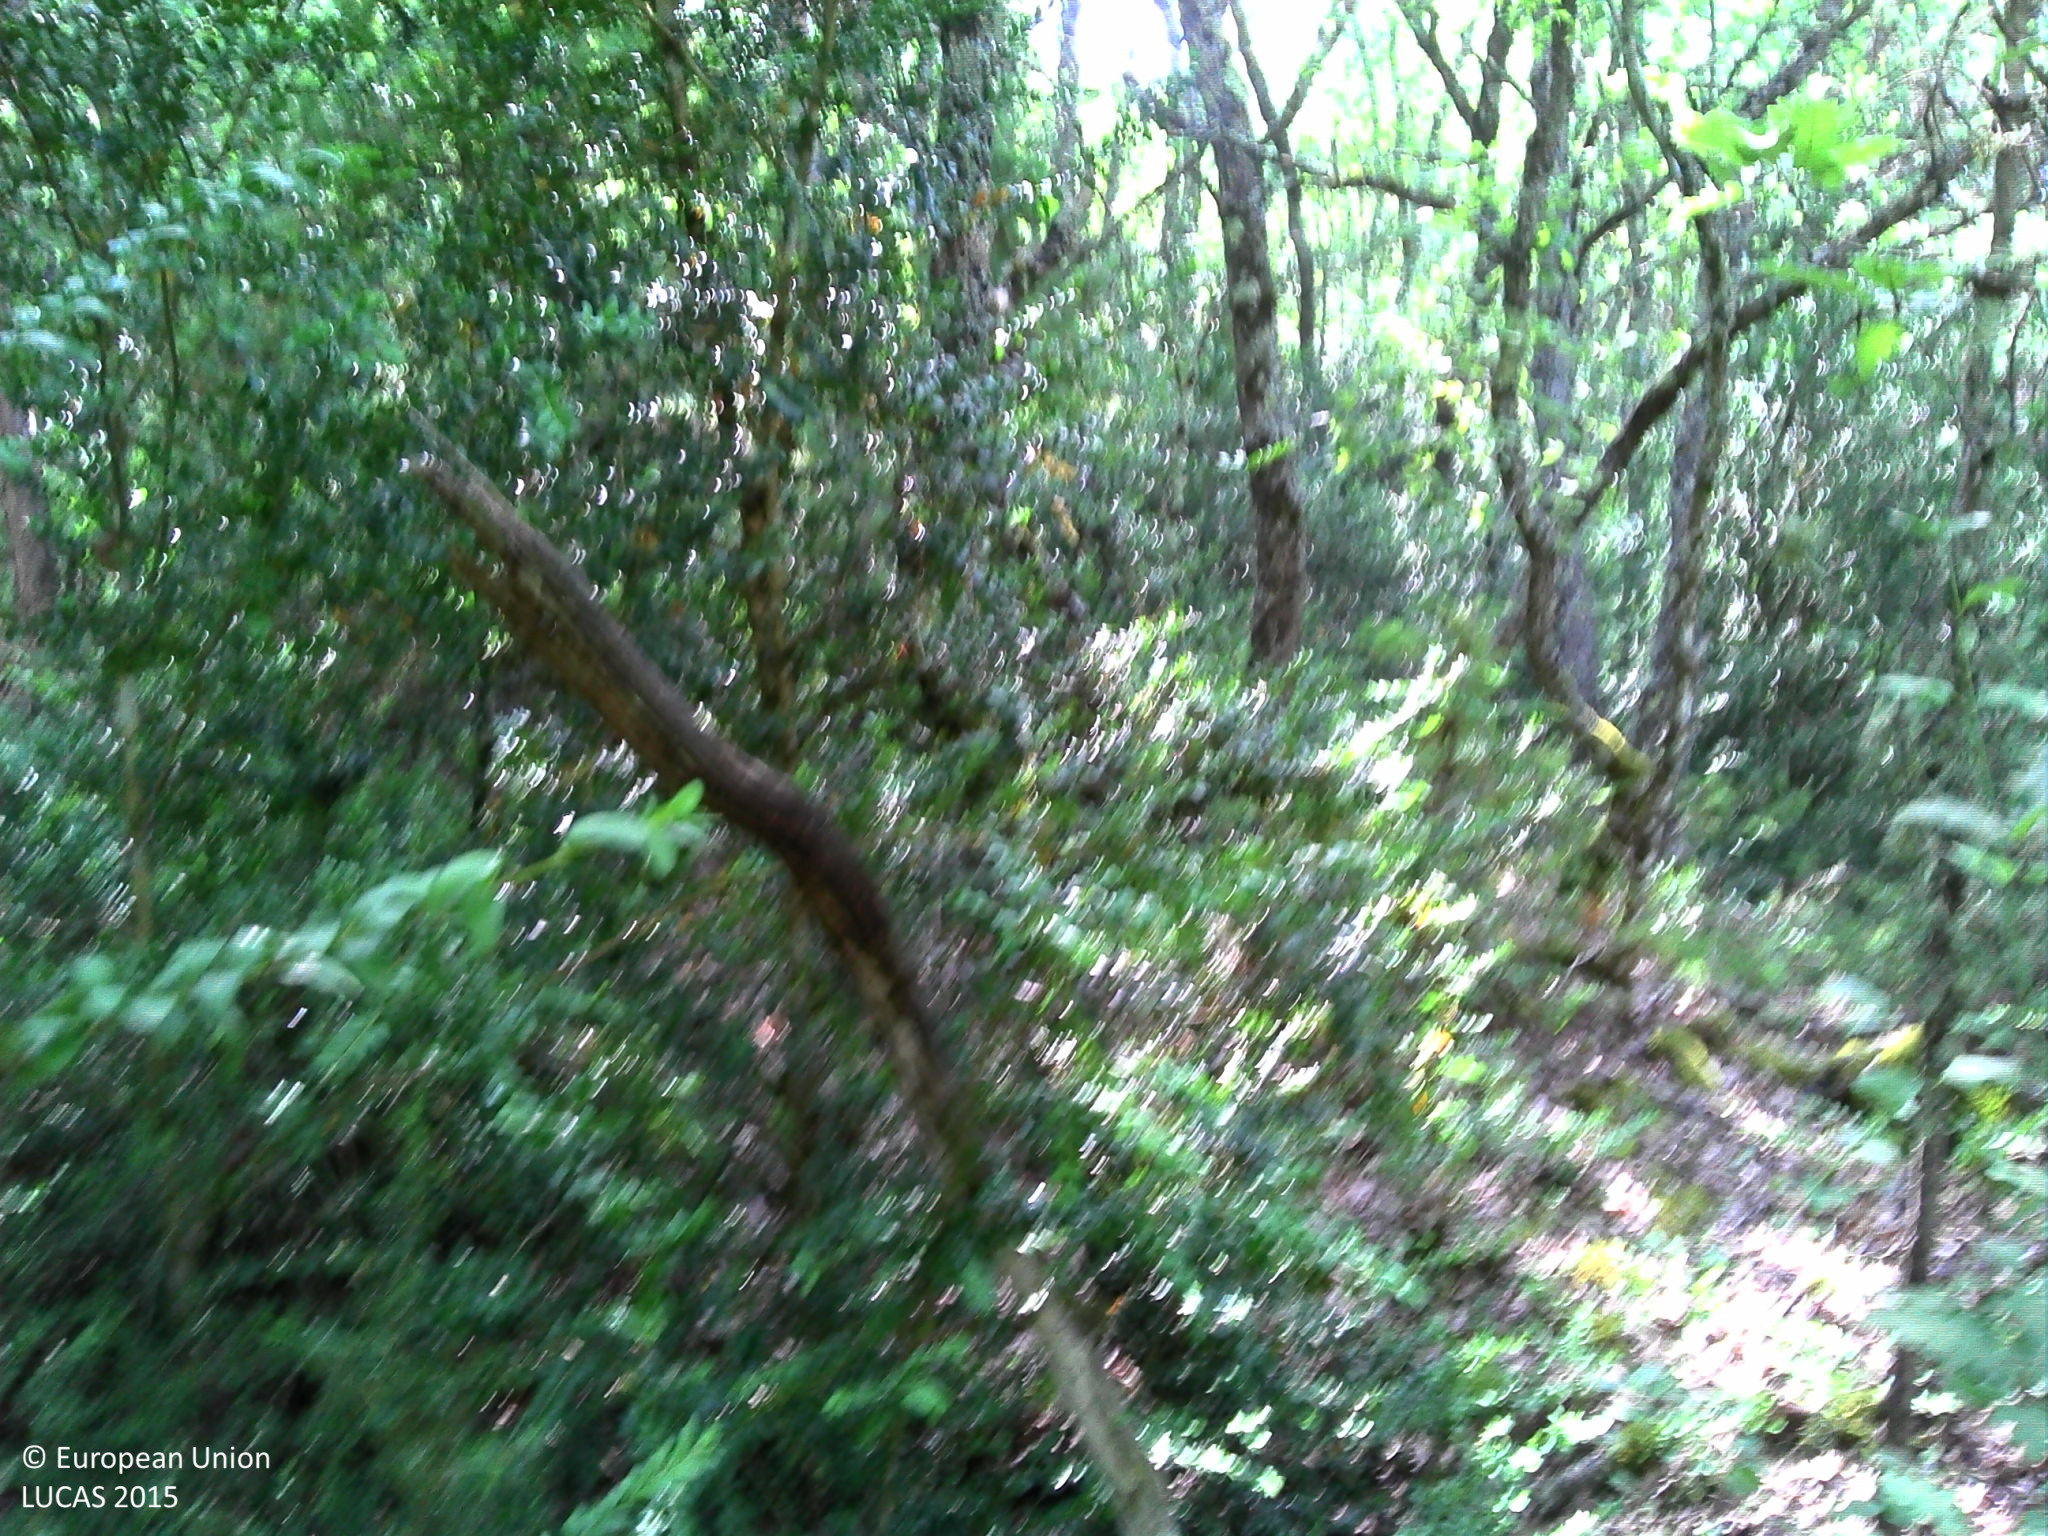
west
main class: Woodland
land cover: Pine dominated mixed woodland
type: coniferous forest of the mediterranean region
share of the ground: > 75 %
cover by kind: coniferous forest trees 40 %, broadleaved forest trees 40 %, shrubs 15 %, herbaceous plants 5 %
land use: Semi-natural and natural areas not in use
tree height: > 5 m
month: July
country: FR
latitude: 43.8426
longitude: 5.6180
